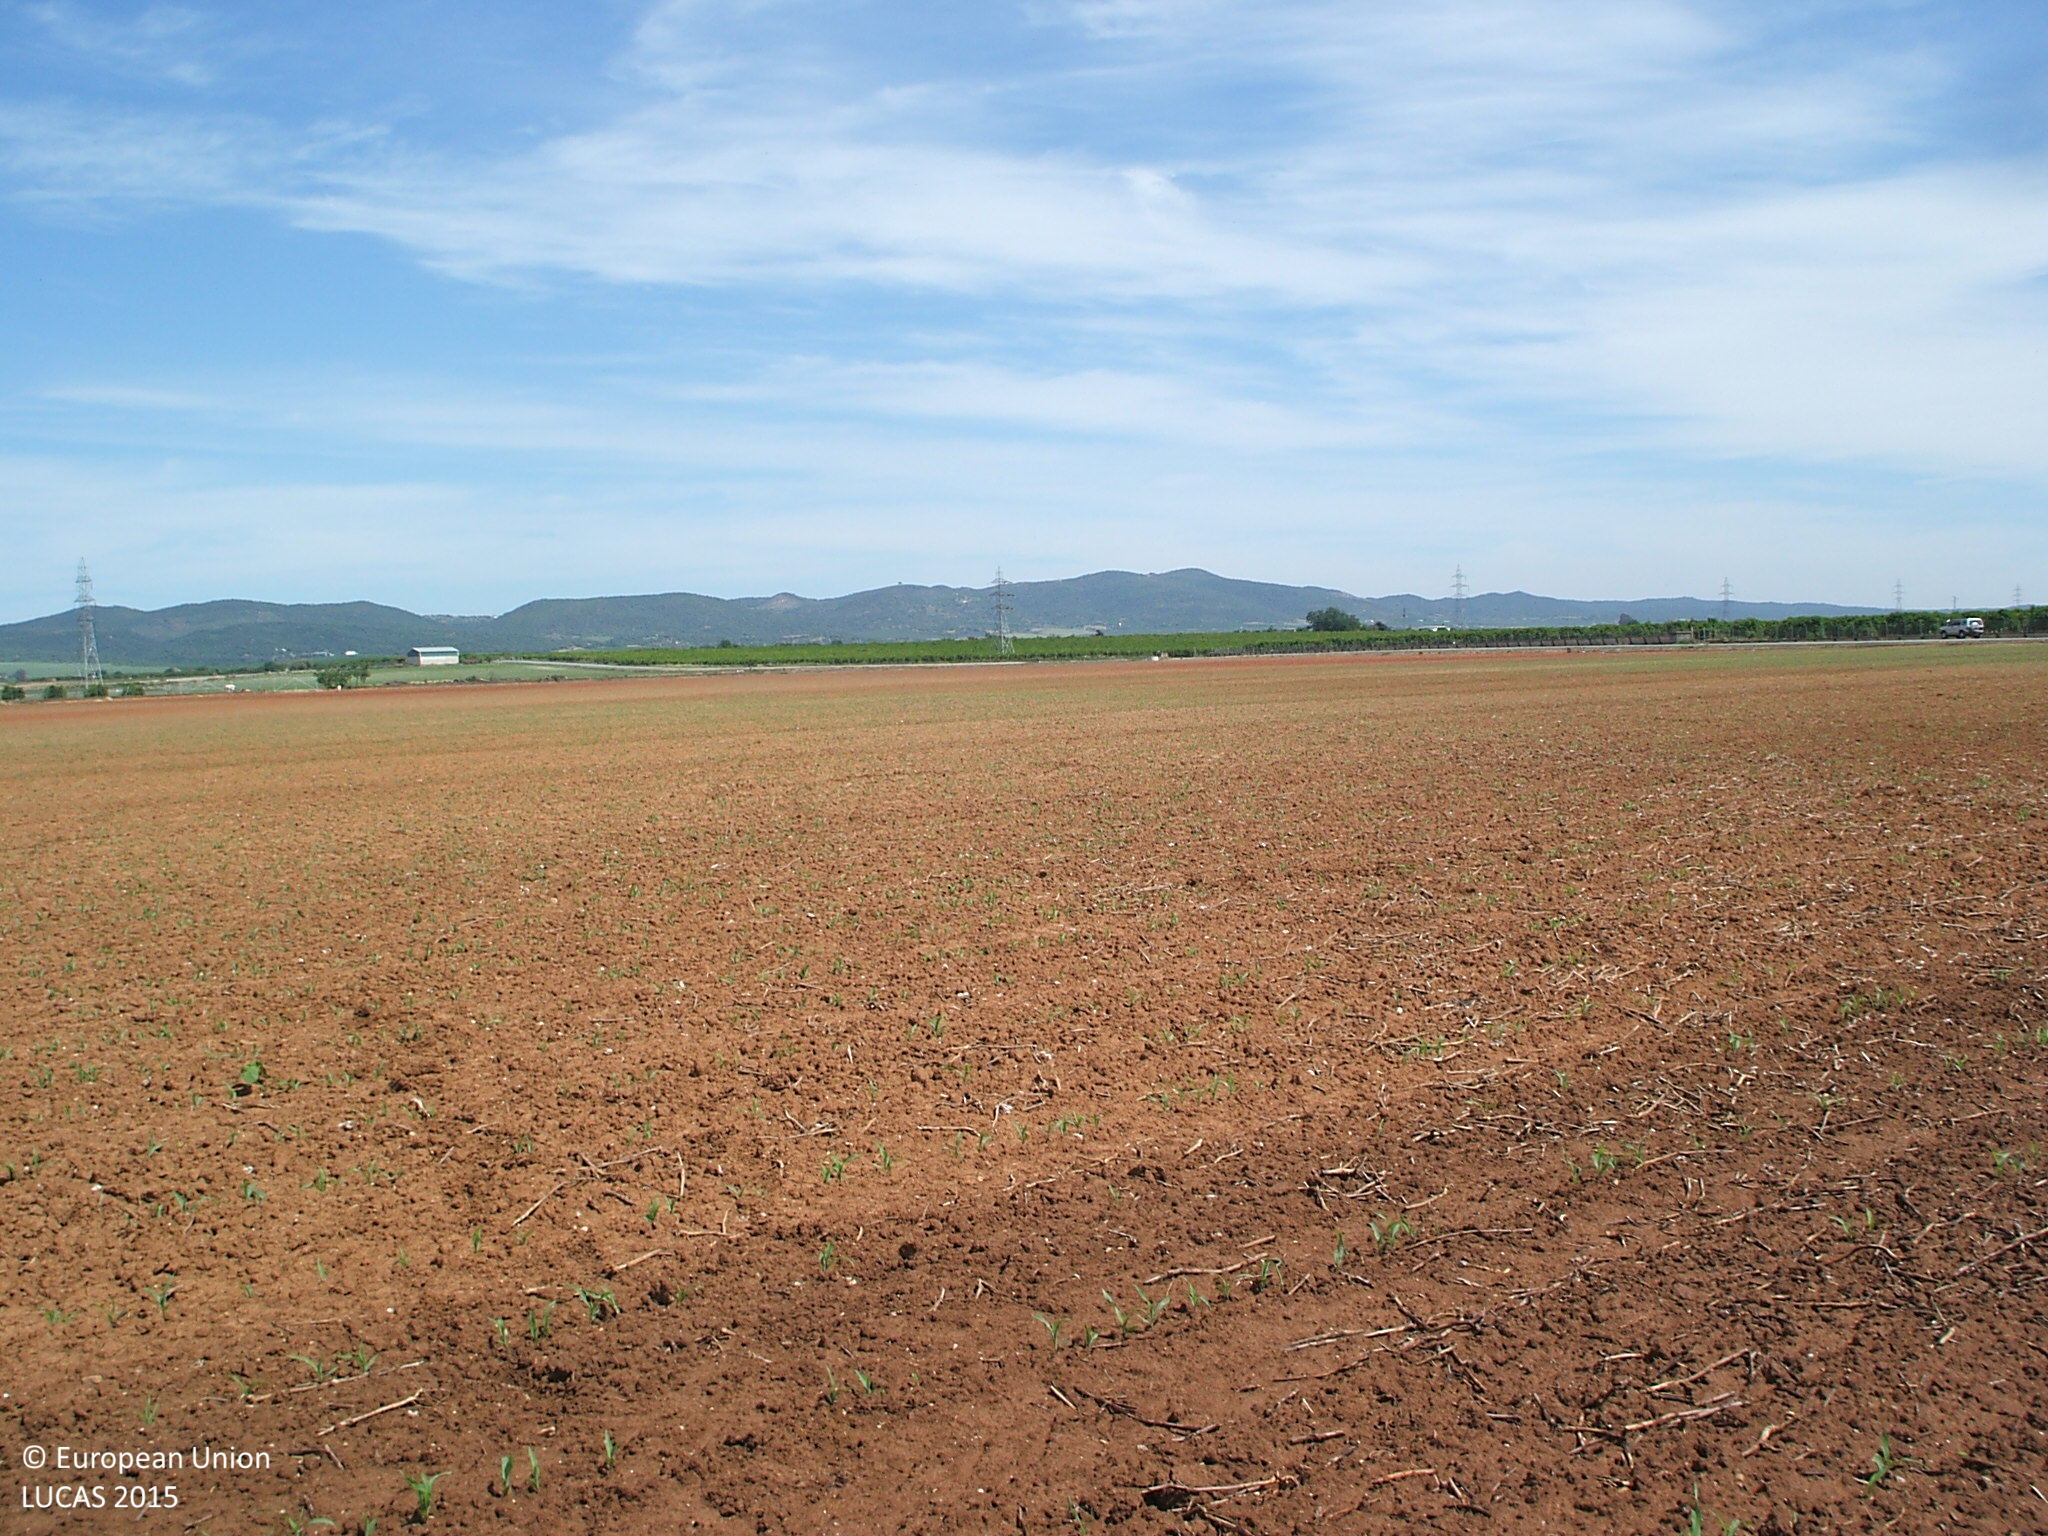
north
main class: Artificial land
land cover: Other artificial areas
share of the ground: < 10 %
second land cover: Maize
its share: < 10 %
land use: Electricity, gas and thermal power distribution
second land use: Agriculture (excluding fallow land and kitchen gardens)
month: April
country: ES
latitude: 37.6913
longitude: -5.4552
